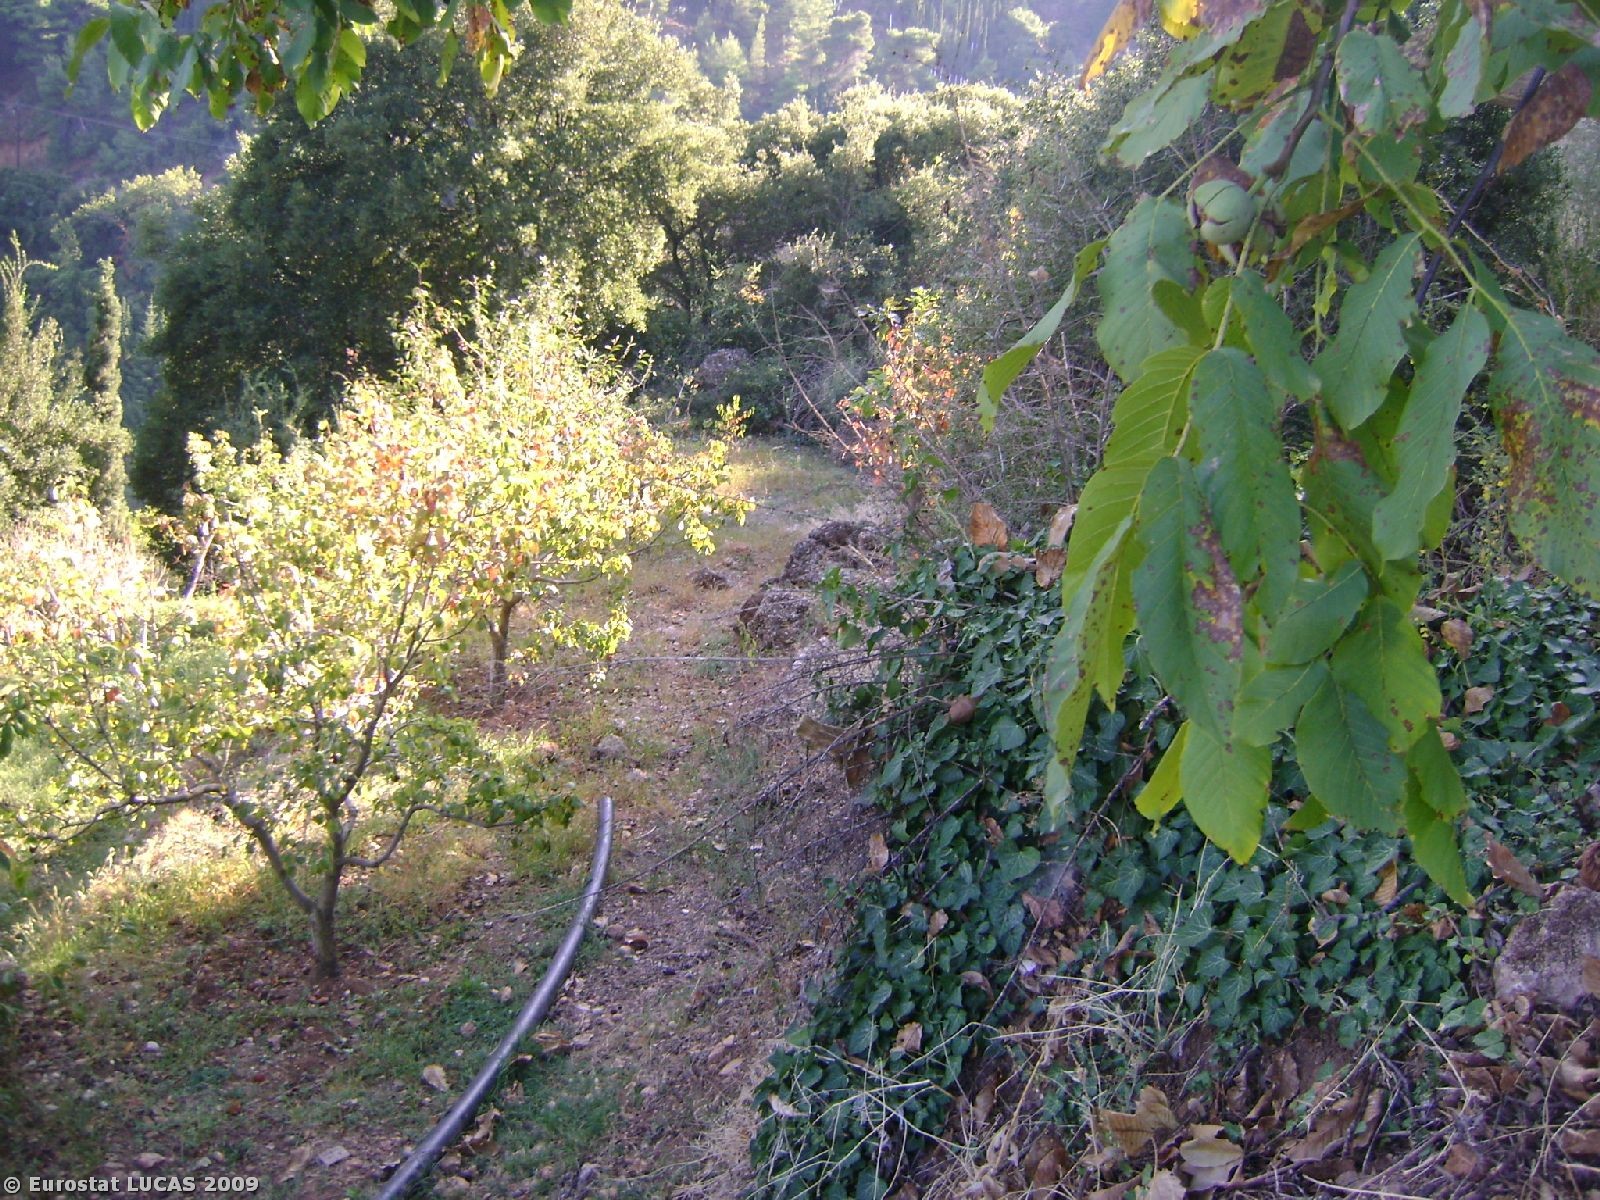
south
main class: Grassland
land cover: Grassland without tree/shrub cover
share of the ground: > 75 %
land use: Unused
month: October
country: GR
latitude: 38.0973
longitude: 22.3190
